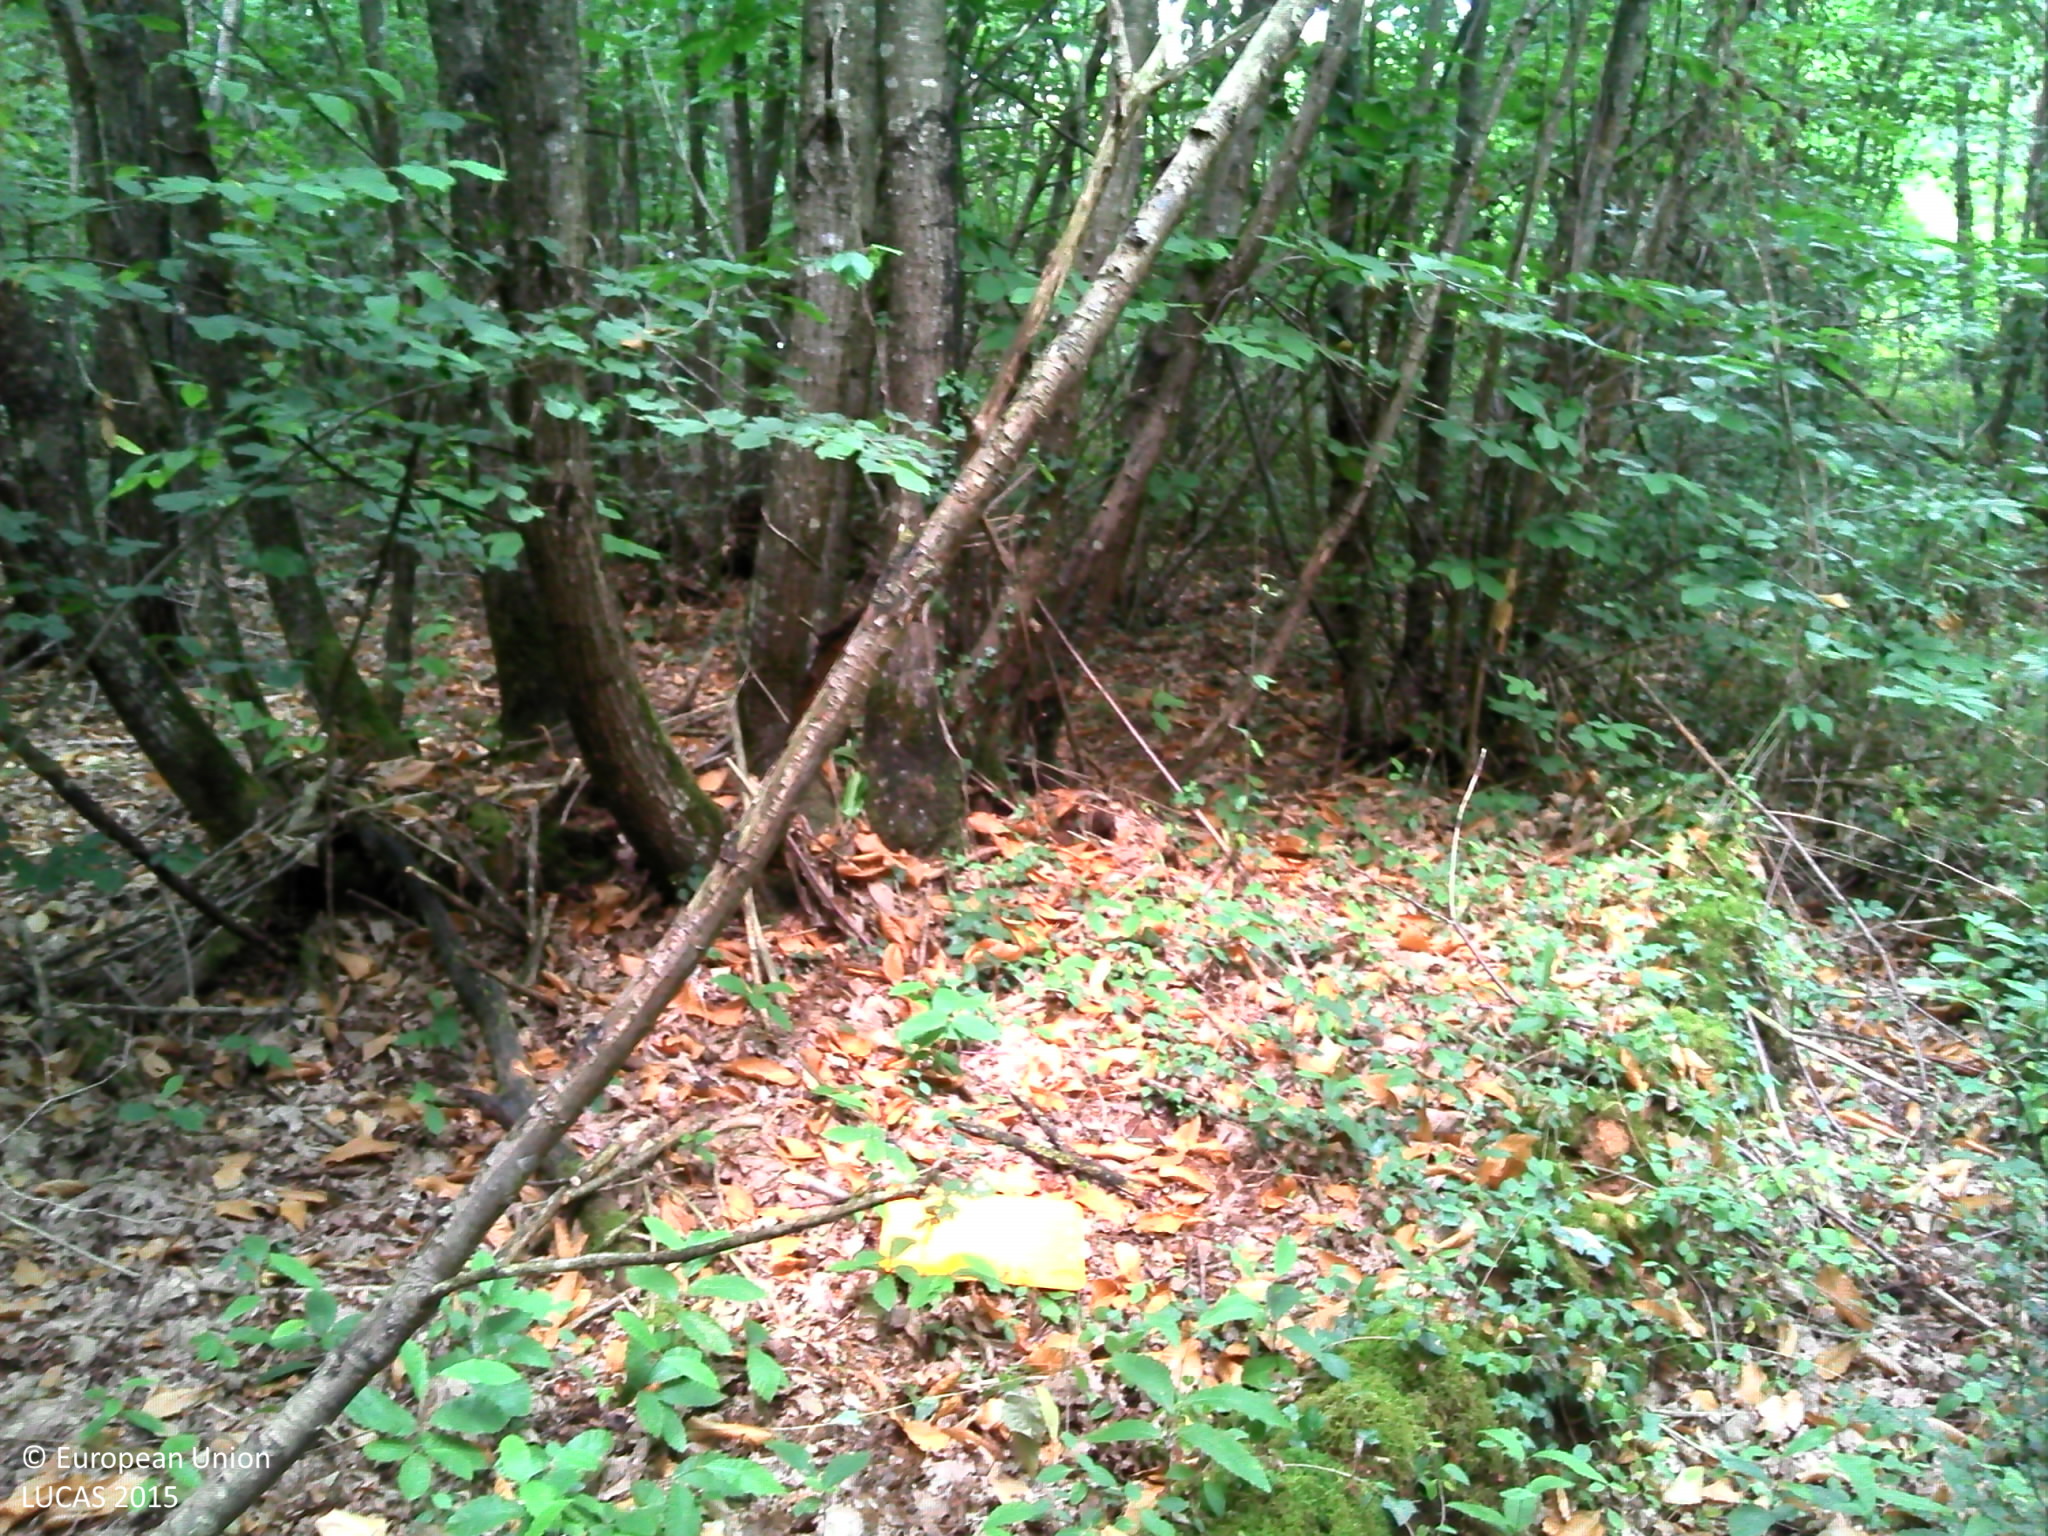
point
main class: Woodland
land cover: Broadleaved woodland
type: acidophilous oak and oak-birch forest
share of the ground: > 75 %
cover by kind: broadleaved forest trees 85 %, shrubs 10 %, herbaceous plants 5 %
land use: Forestry
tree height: > 5 m
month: July
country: FR
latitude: 46.4494
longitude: 0.2562
